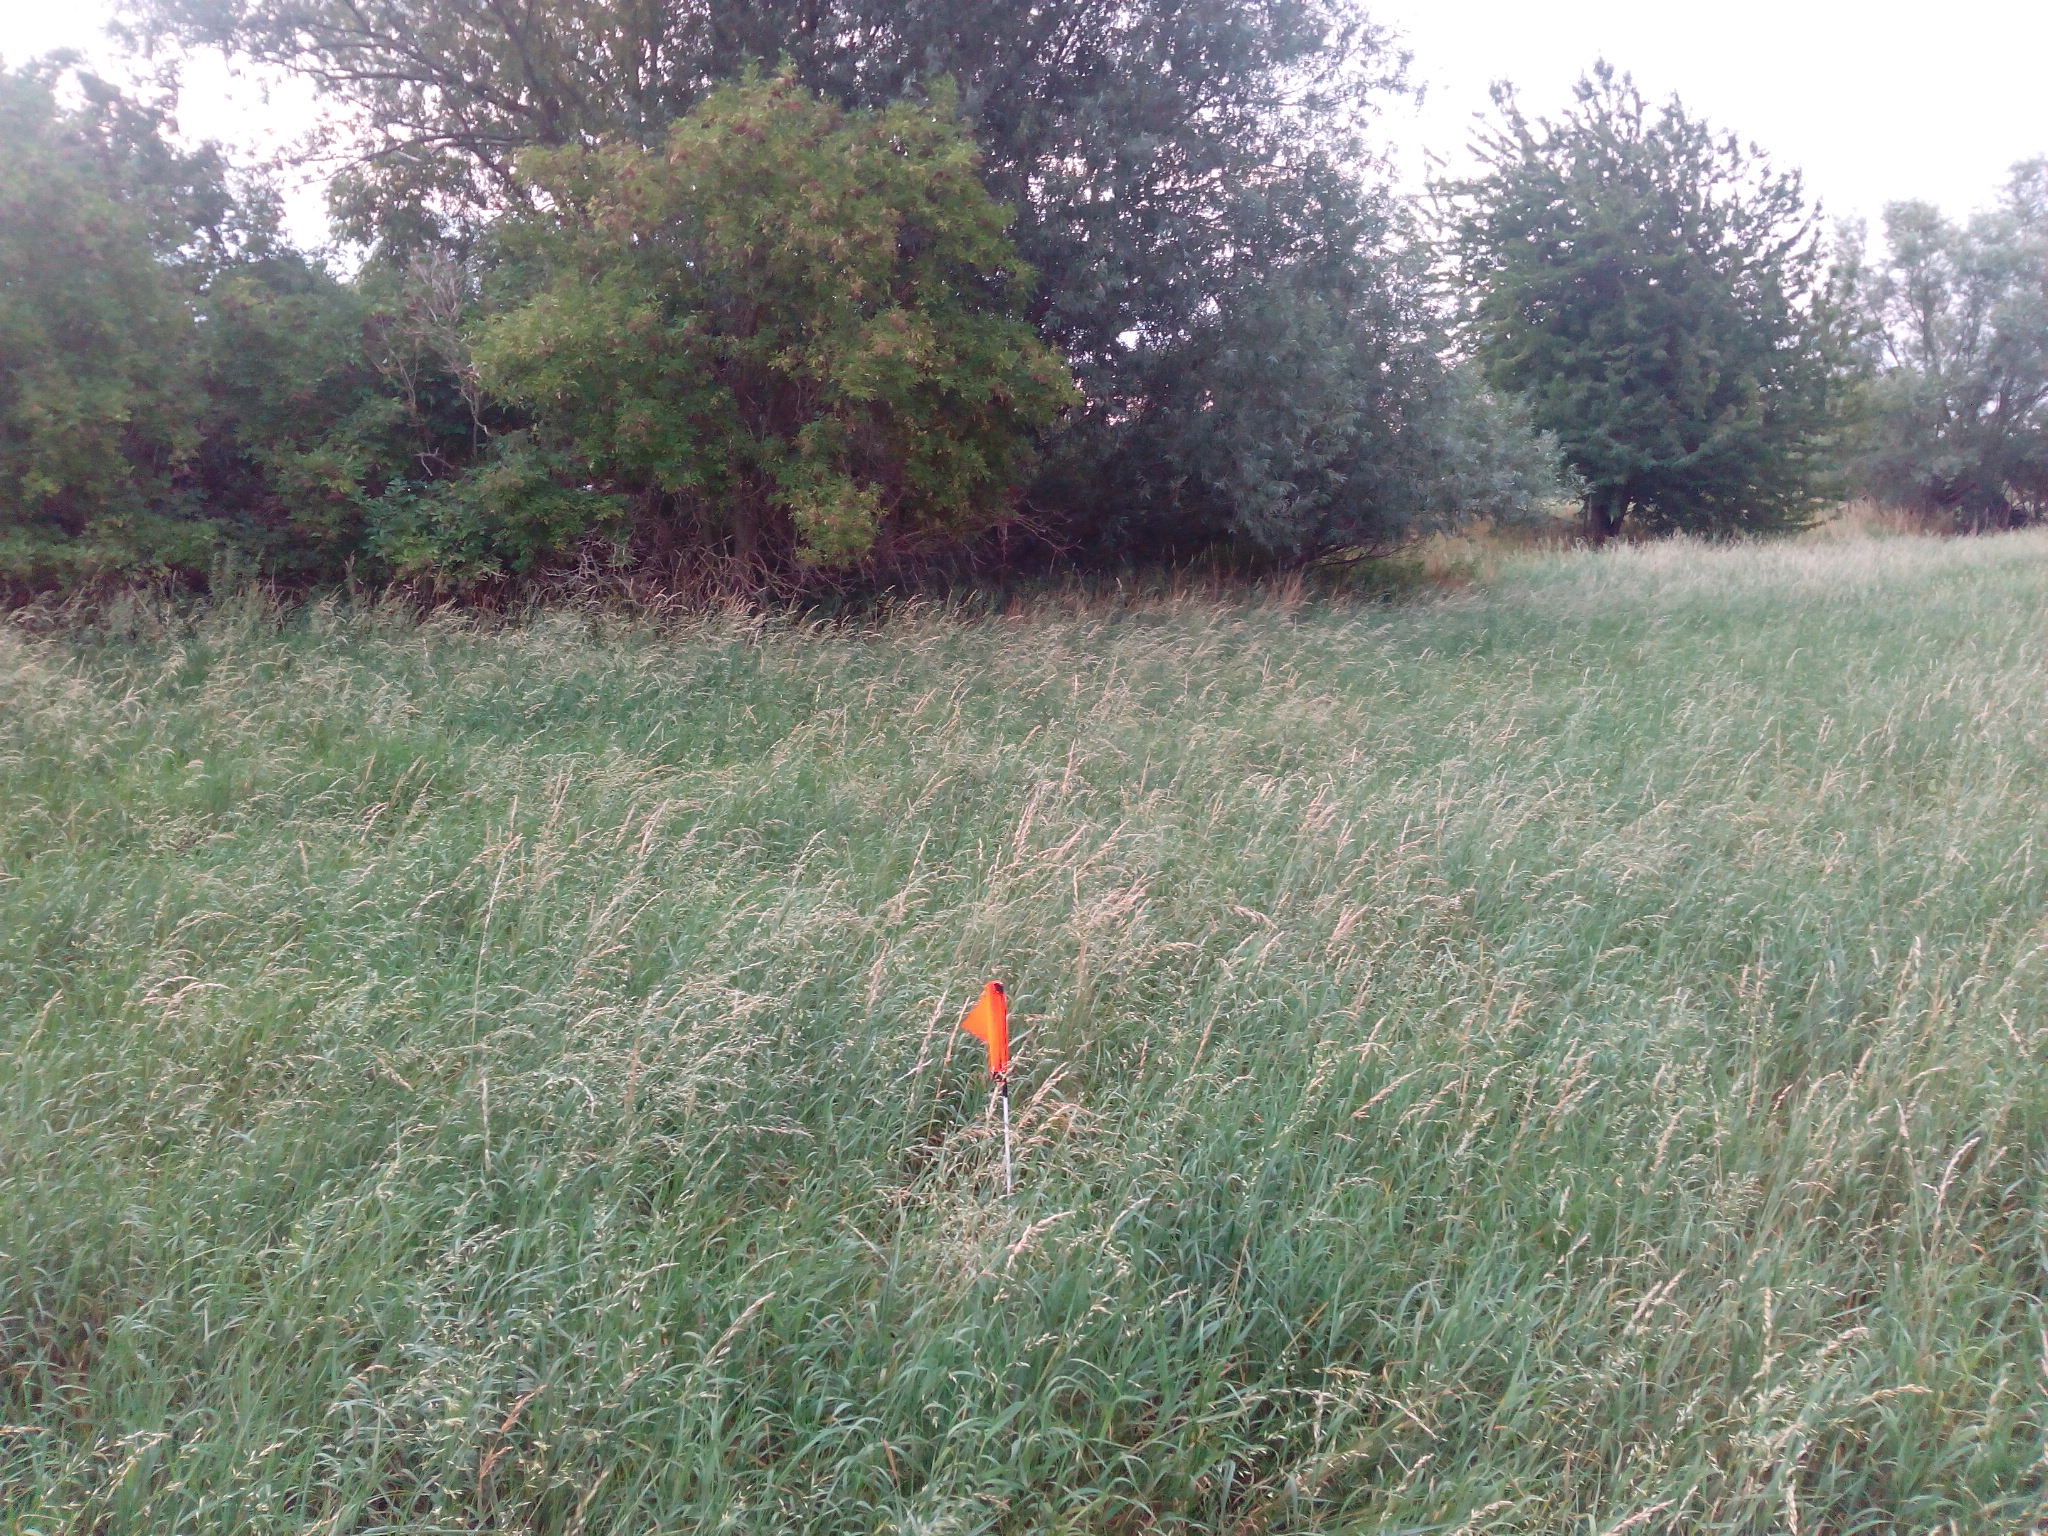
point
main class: Grassland
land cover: Grassland without tree/shrub cover
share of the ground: > 75 %
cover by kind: herbaceous plants 100 %
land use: Agriculture (excluding fallow land and kitchen gardens)
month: August
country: DE
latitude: 52.1617
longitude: 9.9269
